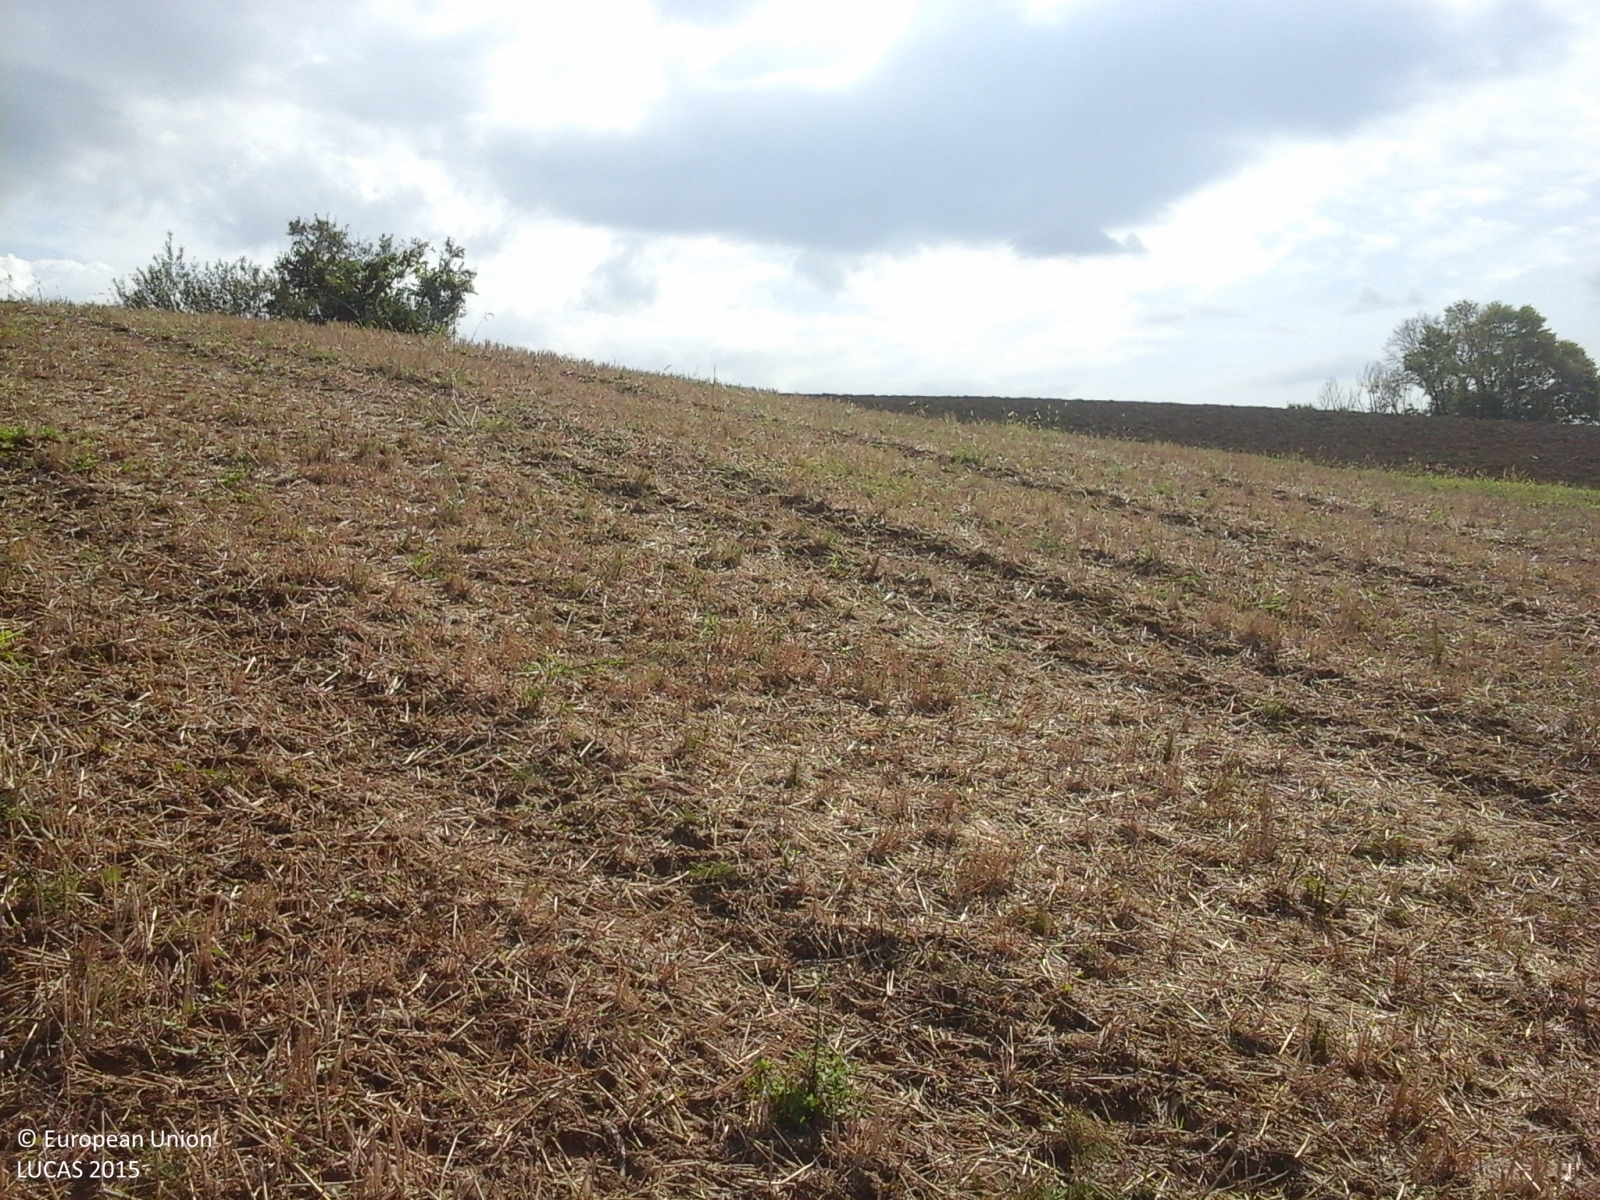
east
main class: Cropland
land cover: Durum wheat
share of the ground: < 10 %
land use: Agriculture (excluding fallow land and kitchen gardens)
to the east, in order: Durum wheat; Other bare soil
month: August
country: IT
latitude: 43.3274
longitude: 13.1612
